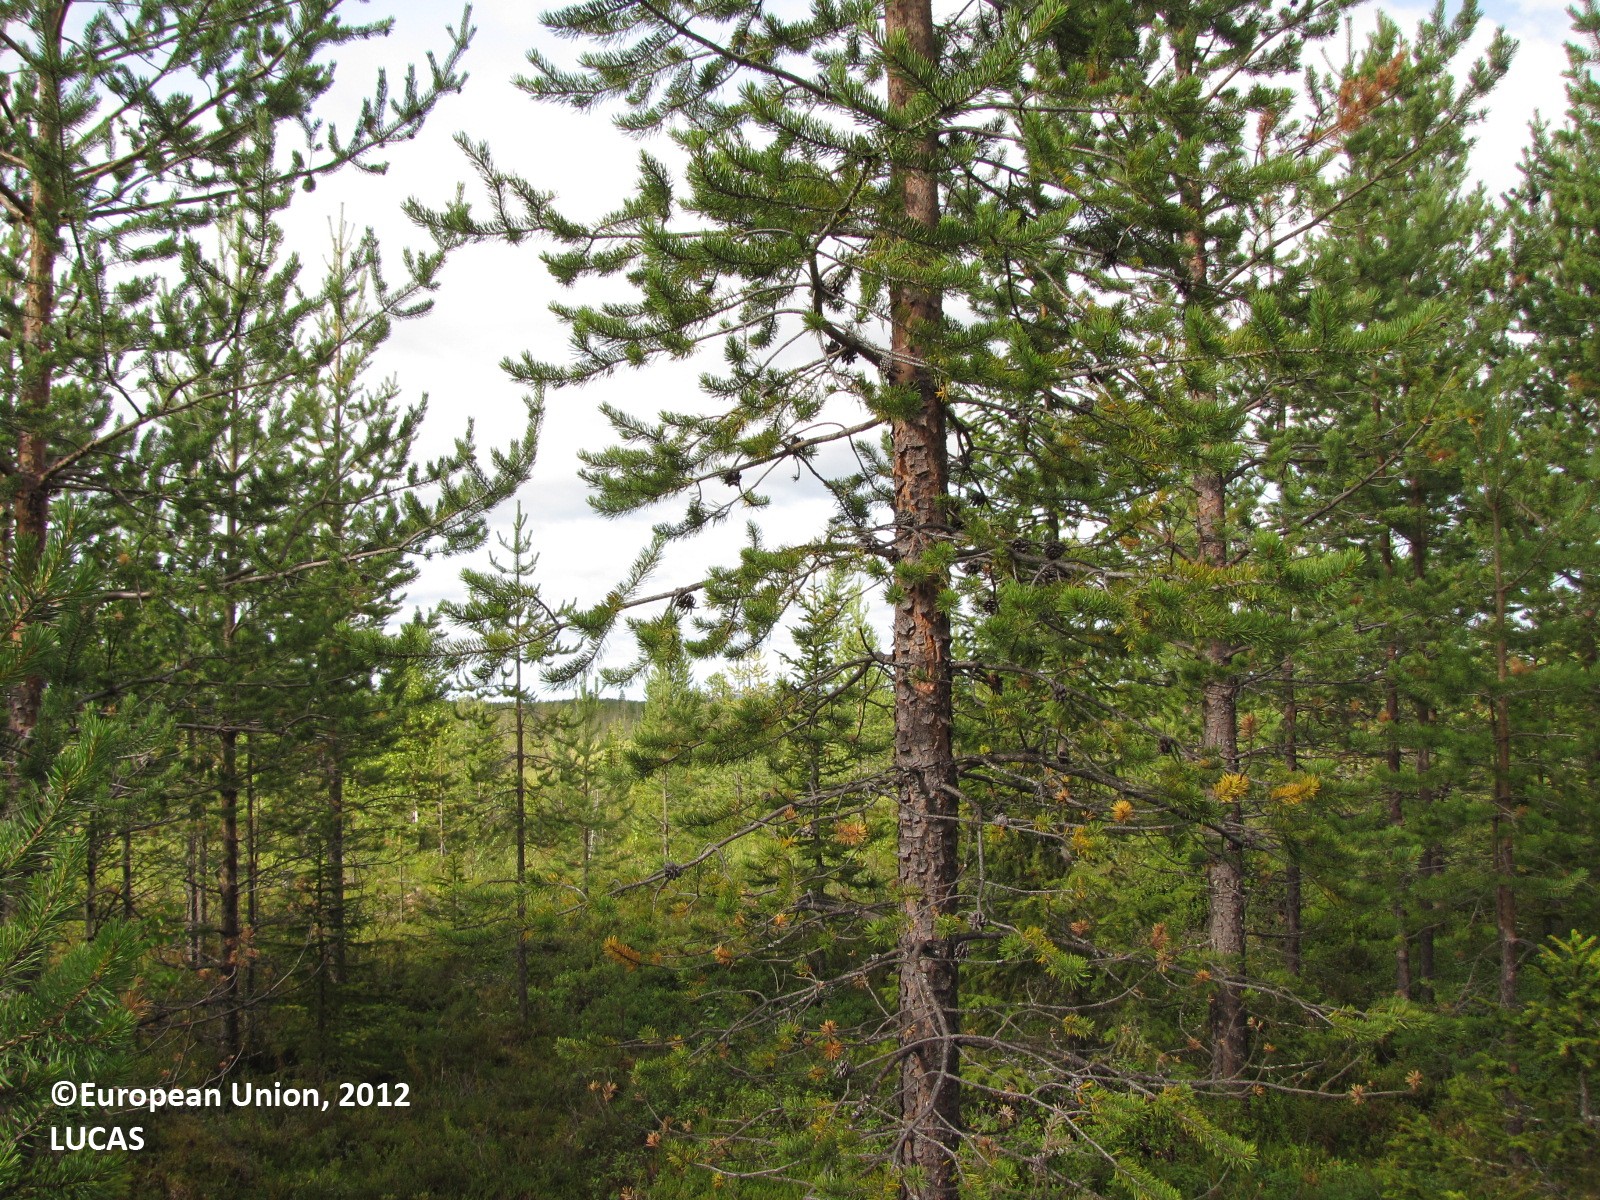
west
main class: Woodland
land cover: Pine dominated coniferous woodland
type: boreal forest
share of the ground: 25 - 50 %
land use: Forestry
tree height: > 5 m
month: August
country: FI
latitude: 66.8913
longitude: 24.6317
